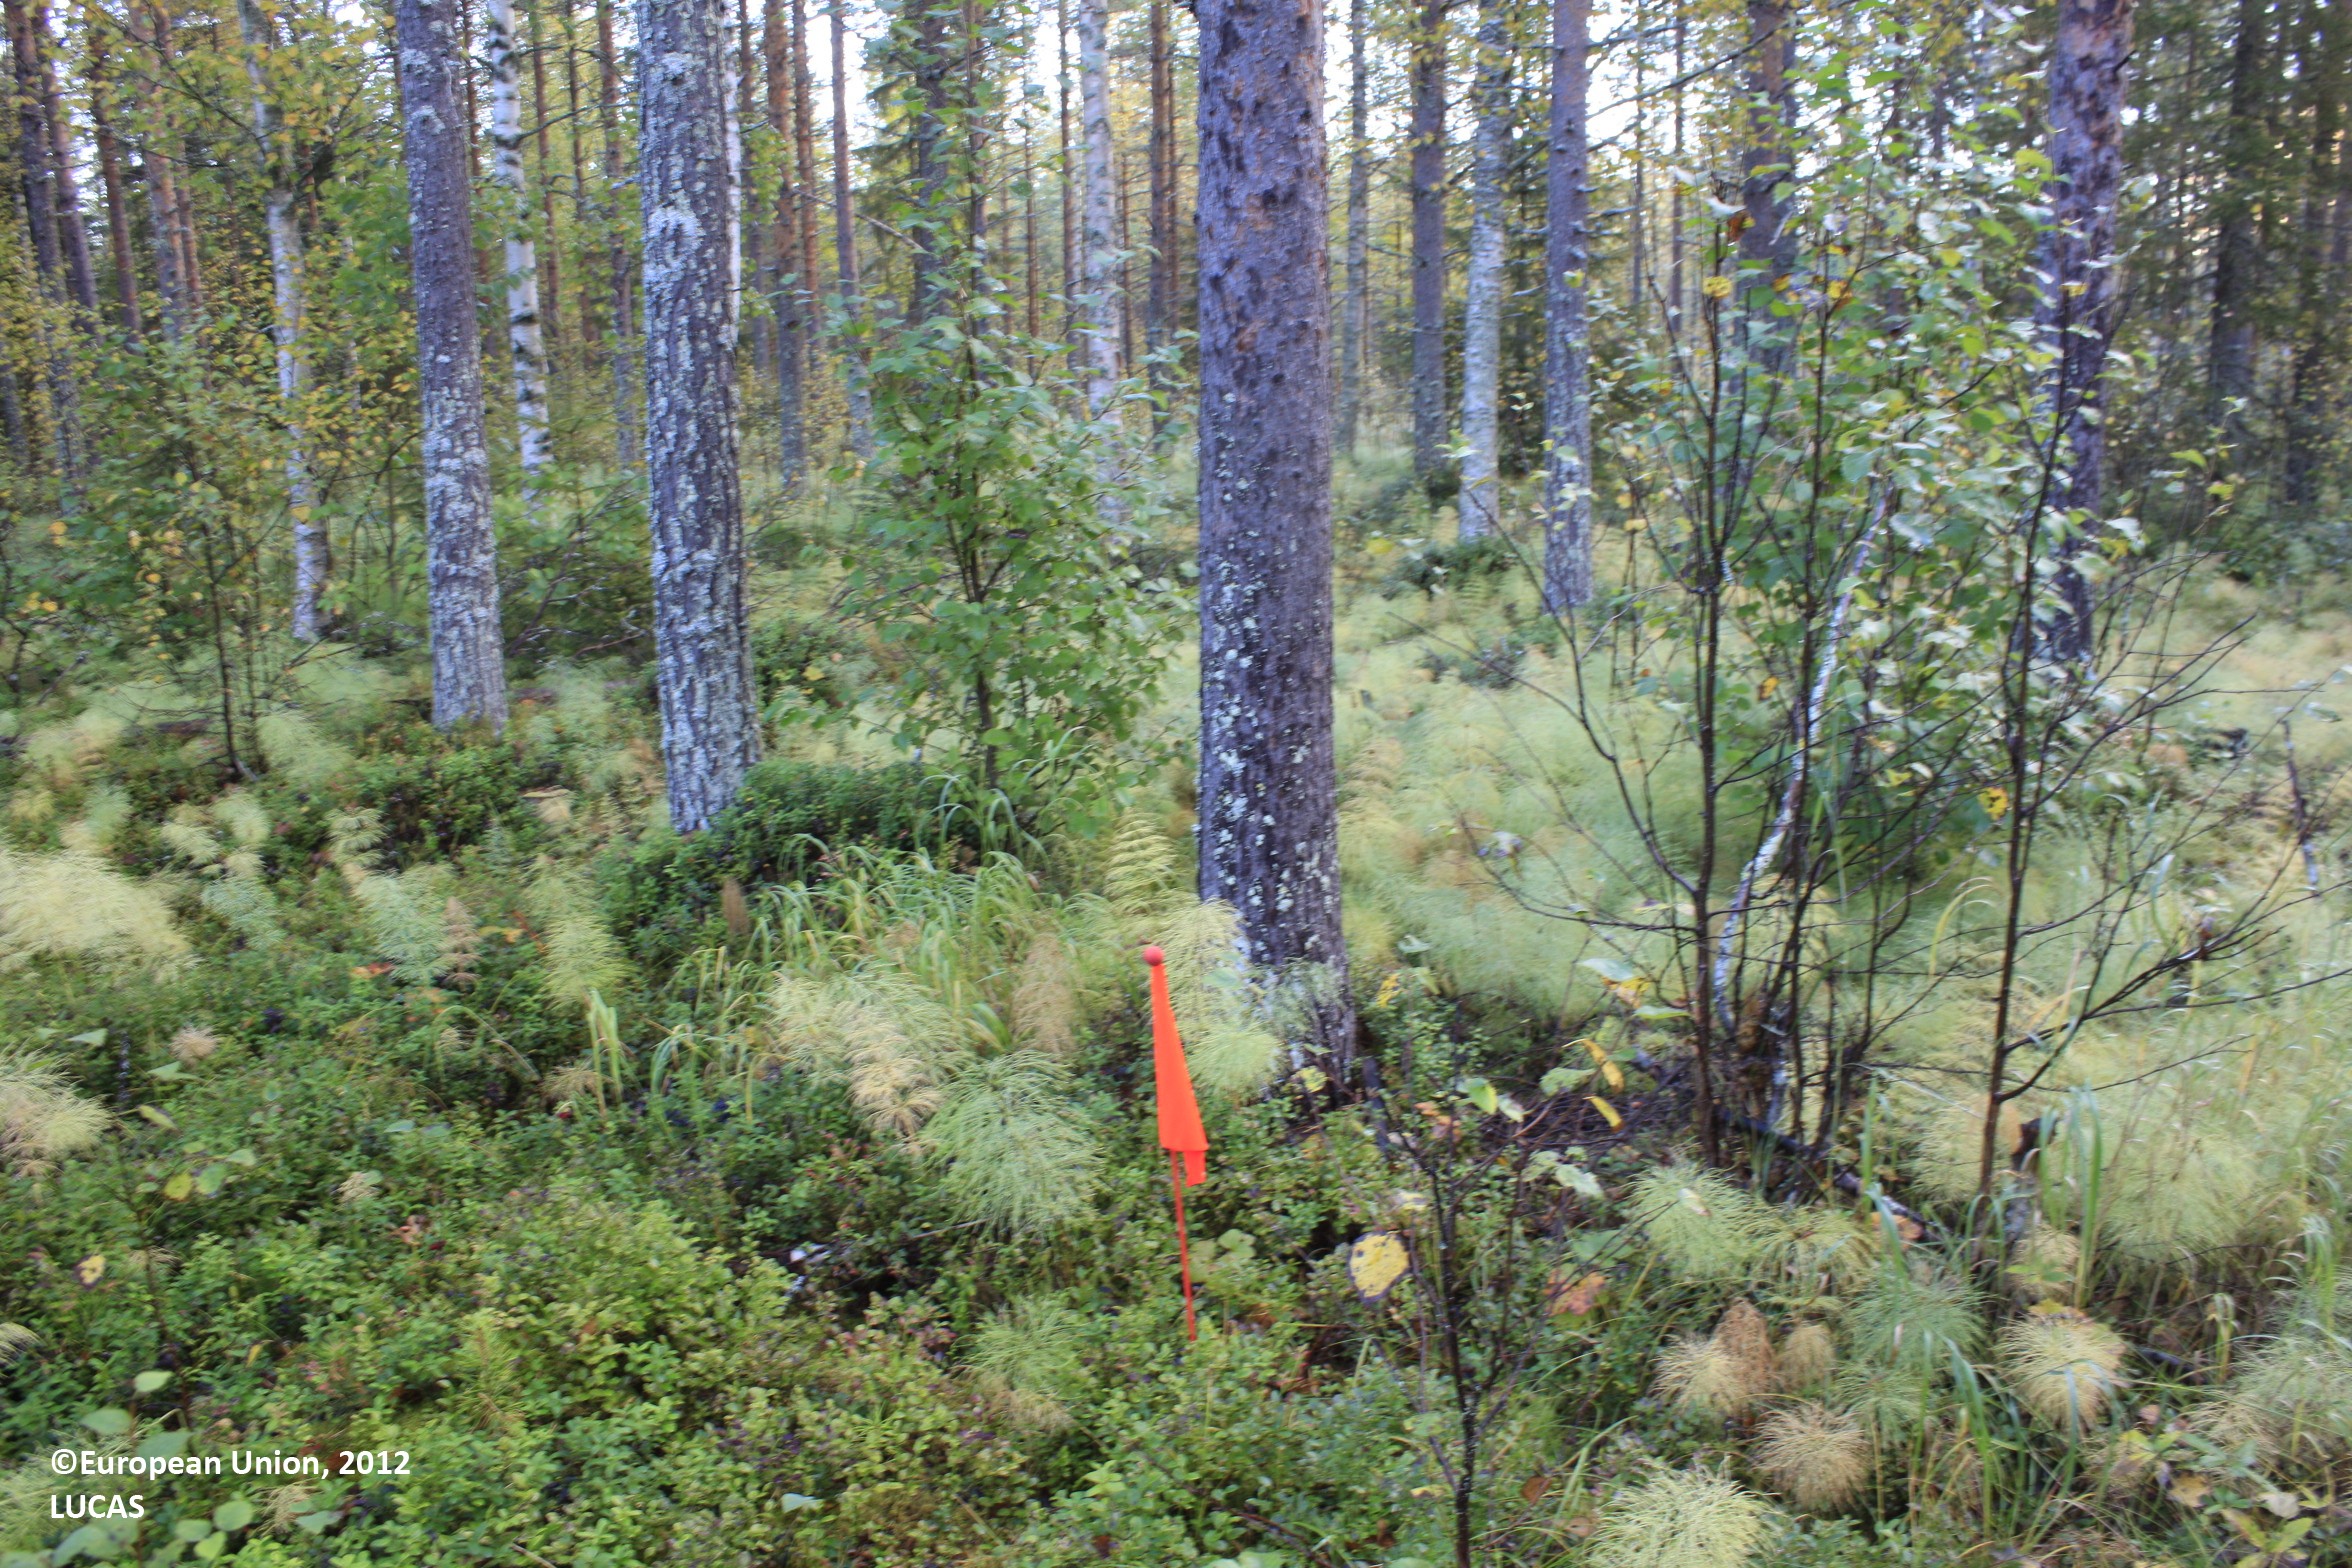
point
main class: Woodland
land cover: Pine dominated mixed woodland
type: boreal forest
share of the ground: 50 - 75 %
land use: Forestry
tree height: > 5 m
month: September
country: FI
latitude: 65.4797
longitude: 26.6246
